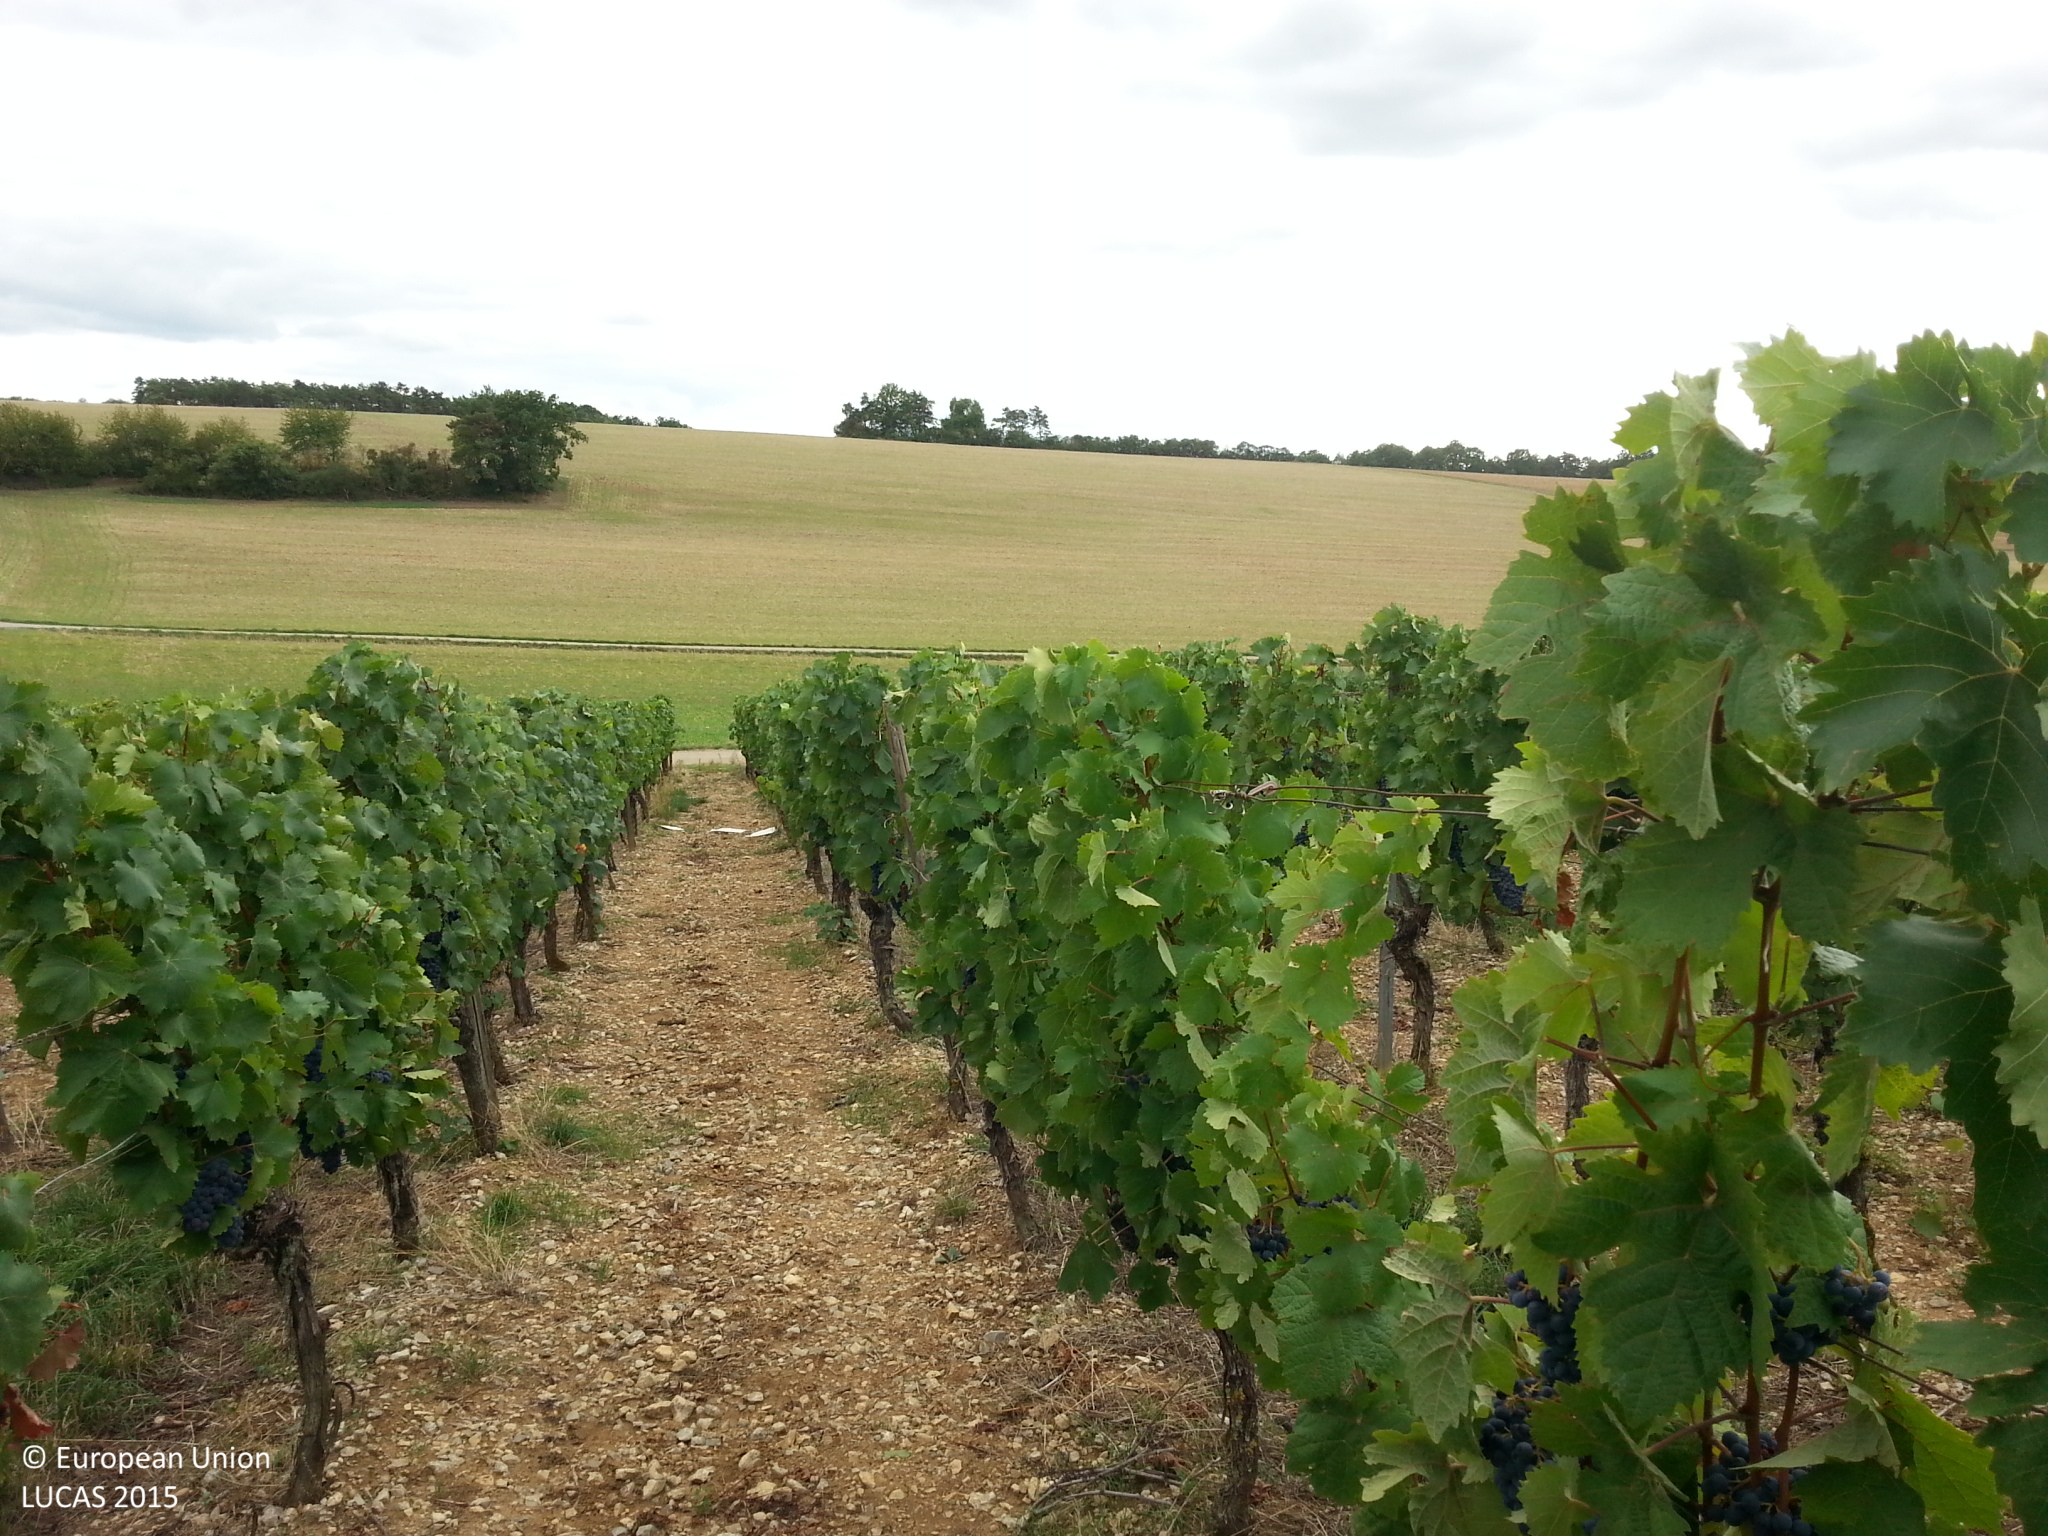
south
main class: Cropland
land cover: Vineyards
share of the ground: 50 - 75 %
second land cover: Spontaneously vegetated surfaces
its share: 10 - 25 %
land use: Agriculture (excluding fallow land and kitchen gardens)
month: September
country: DE
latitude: 49.6080
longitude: 9.5988
